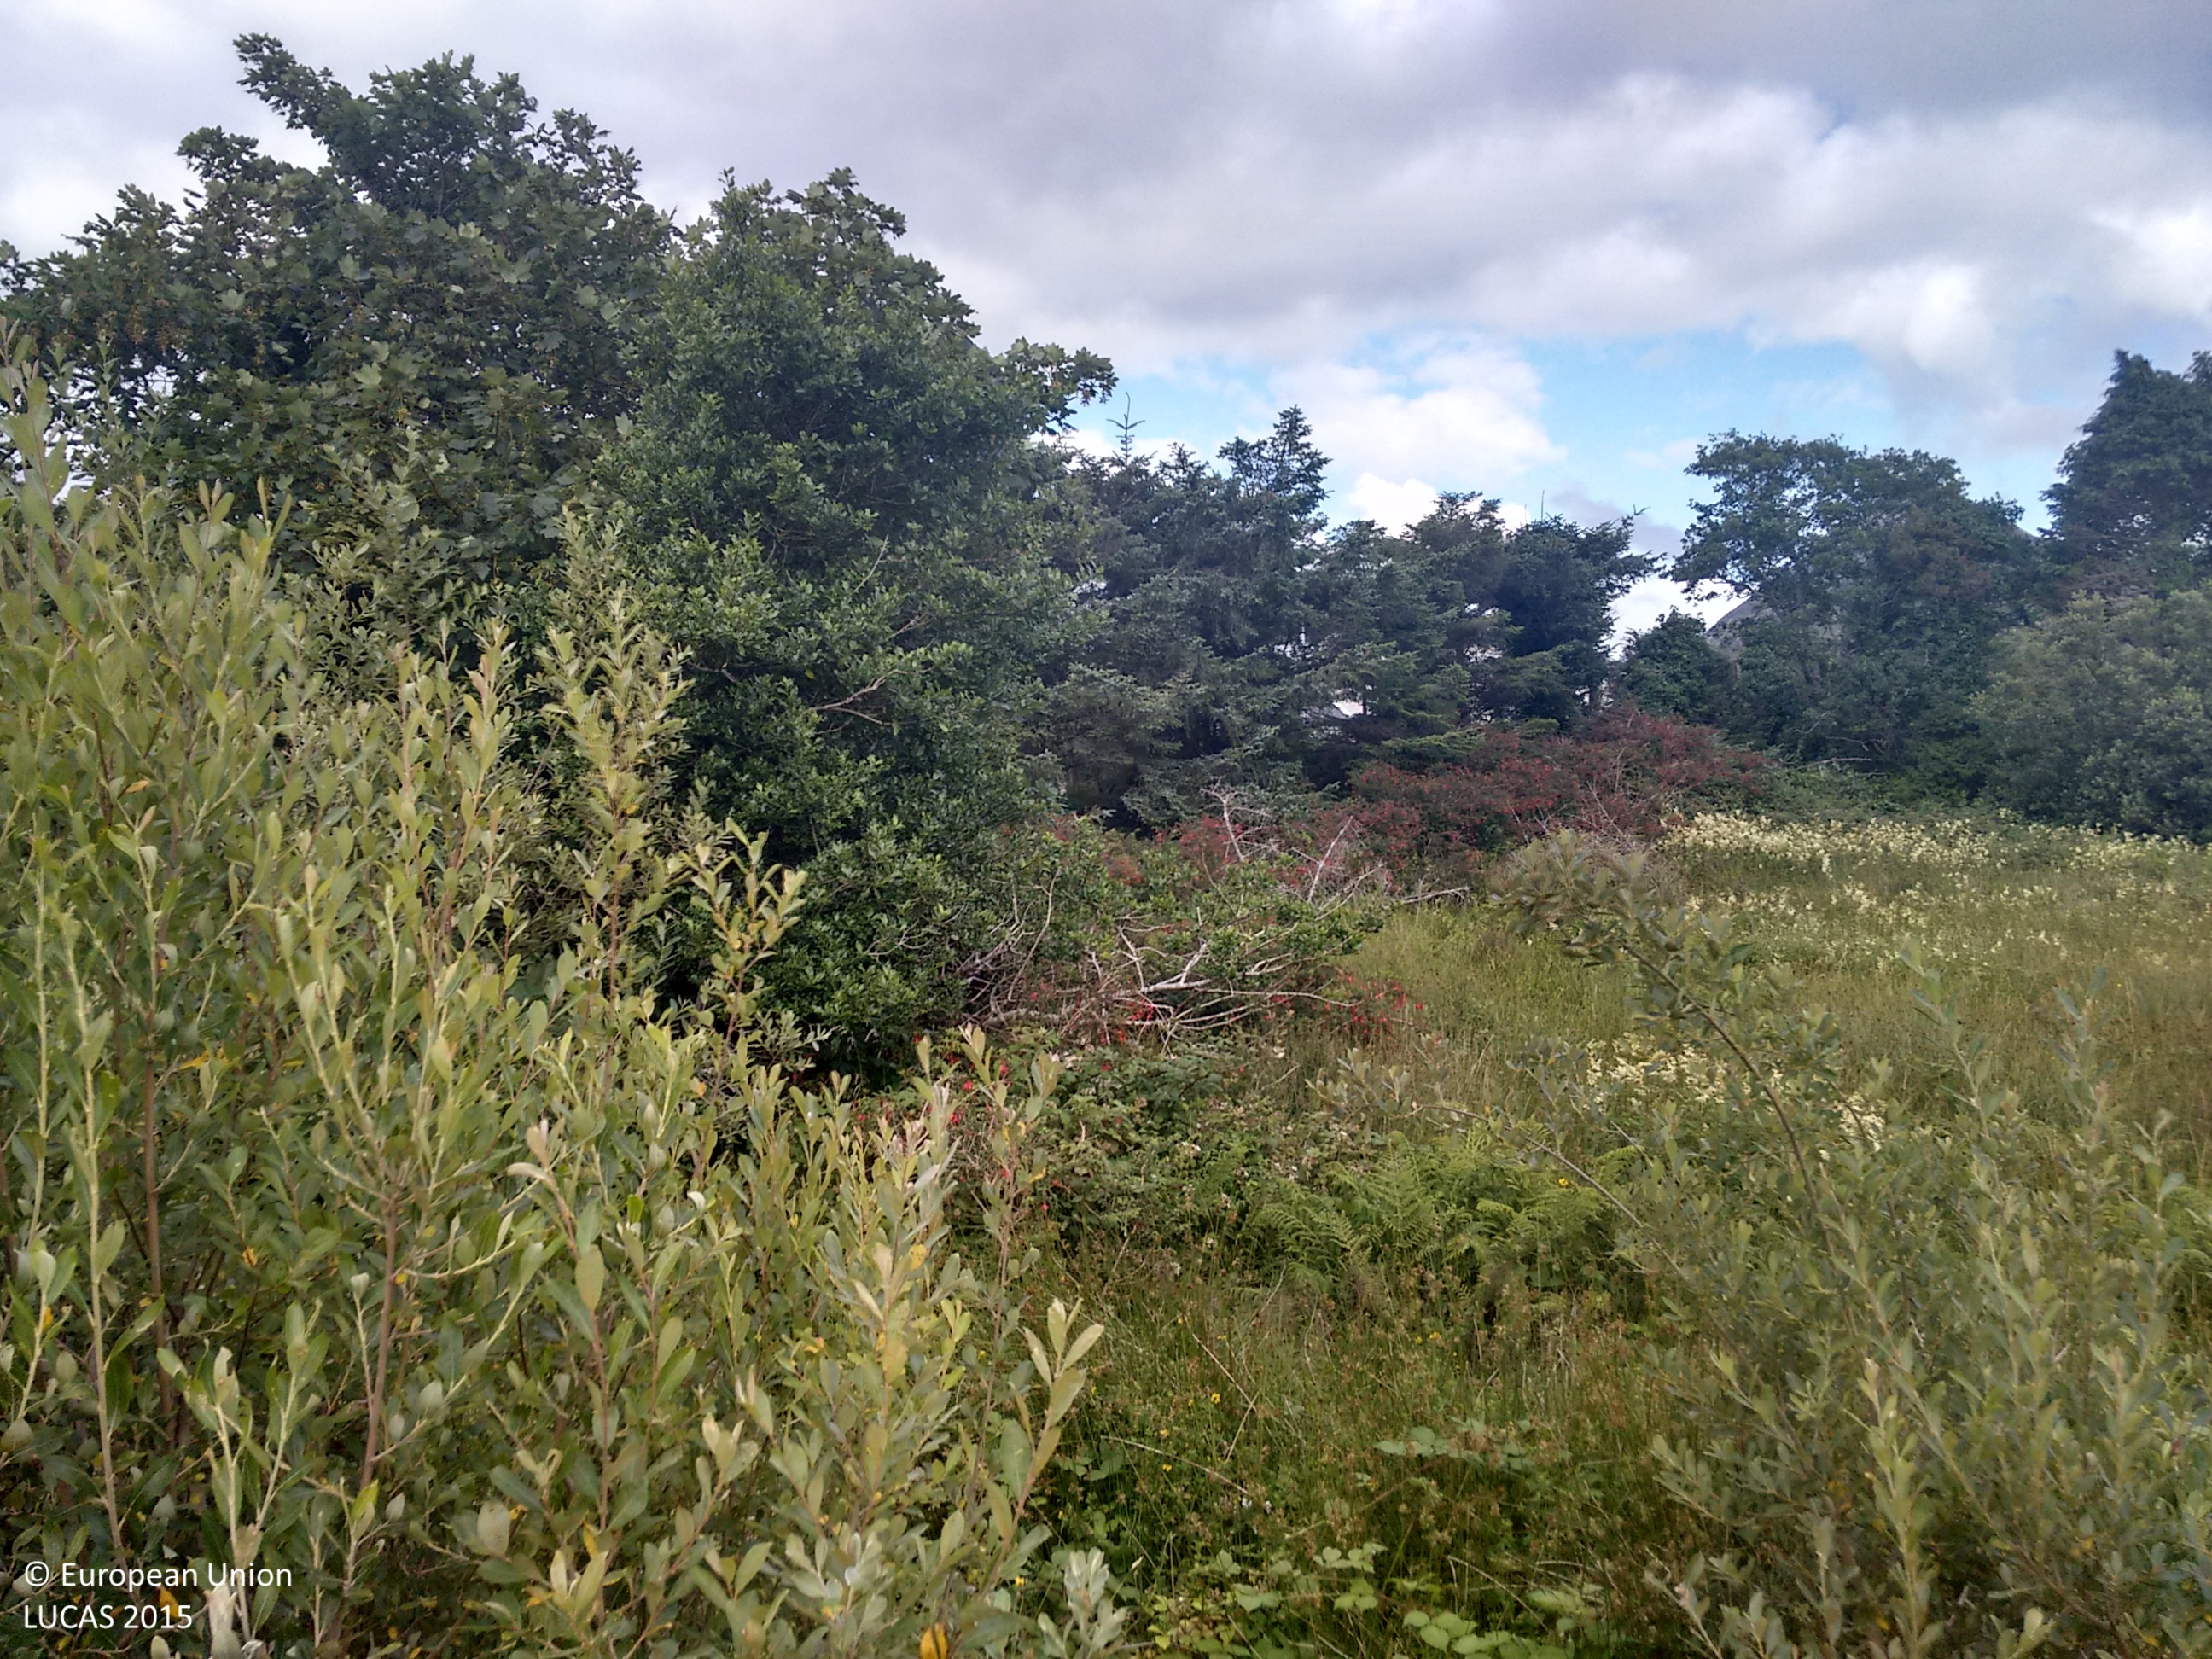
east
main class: Grassland
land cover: Grassland with sparse tree/shrub cover
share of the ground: > 75 %
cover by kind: herbaceous plants 85 %, shrubs 10 %, broadleaved forest trees 5 %
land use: Semi-natural and natural areas not in use
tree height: < 5 m
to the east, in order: Grassland with sparse tree/shrub cover; Broadleaved woodland; Artificial constructions in urban areas; Broadleaved woodland; Other bare soil
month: July
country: IE
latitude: 53.5539
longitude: -9.9500
